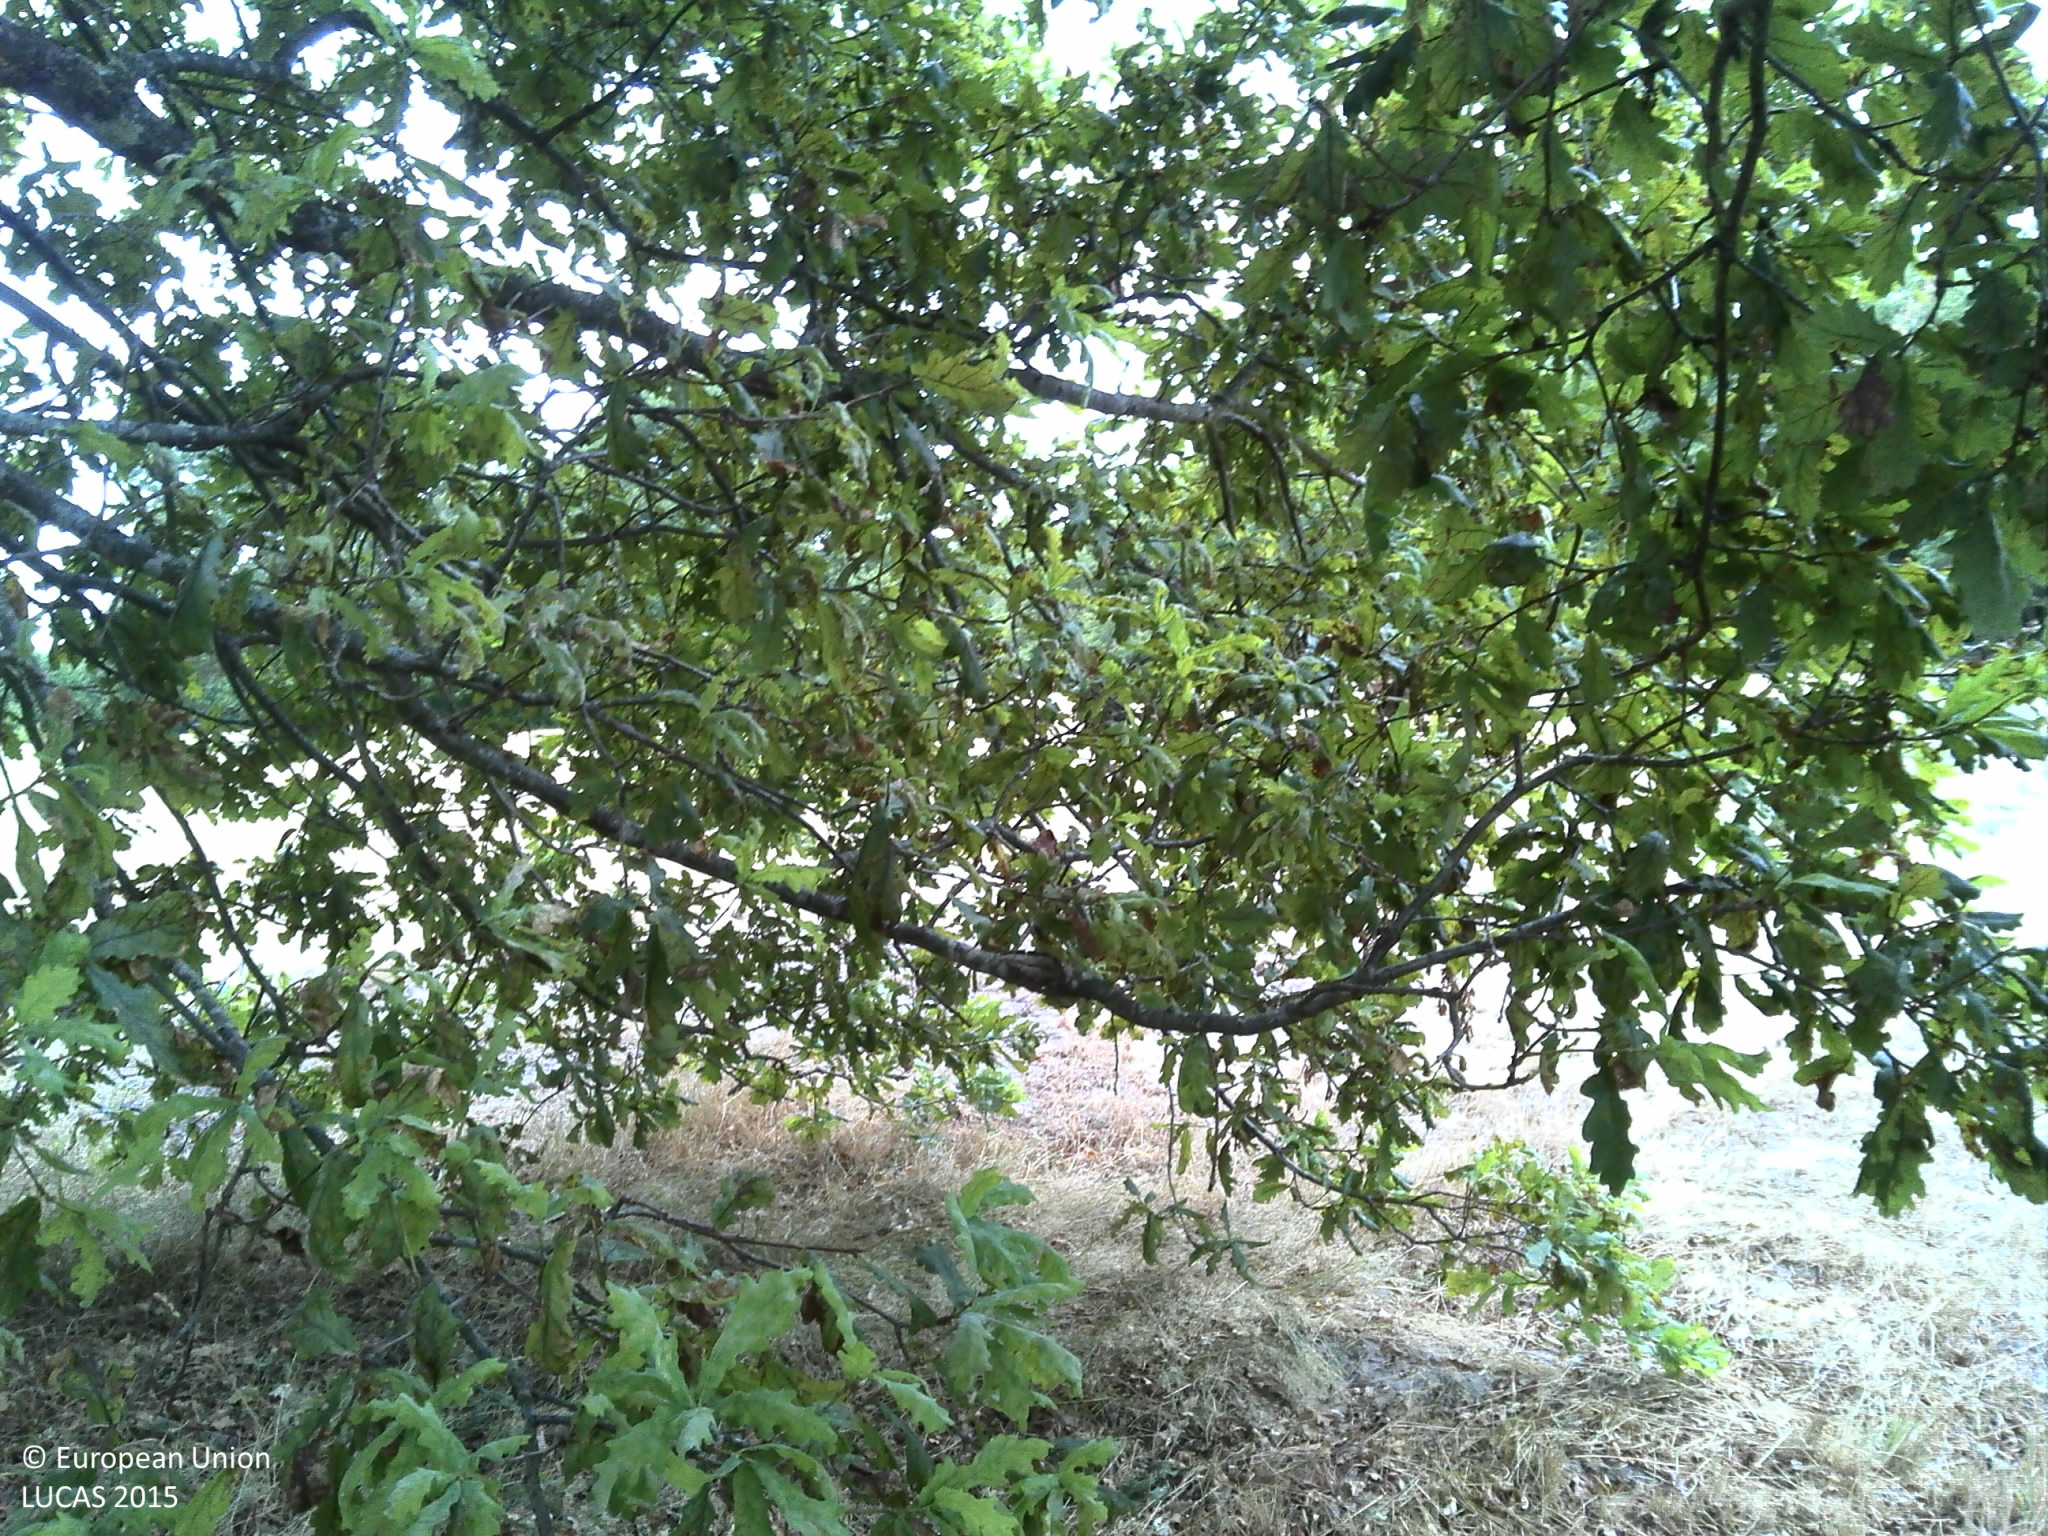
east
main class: Shrubland
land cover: Shrubland with sparse tree cover
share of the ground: > 75 %
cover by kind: herbaceous plants 50 %, shrubs 45 %, broadleaved forest trees 5 %
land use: Agriculture (excluding fallow land and kitchen gardens)
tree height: < 5 m
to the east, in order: Shrubland with sparse tree cover; Fences; Grass margins; Ditches and canals; Other bare soil; Grassland without tree/shrub cover; Fences; Grassland without tree/shrub cover; Other fresh vegetables; Fences; Grassland without tree/shrub cover; Ditches and canals; Electric lines; Grass margins; Paved roads, cycling and walking lanes; Grass margins; Ditches and canals
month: August
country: FR
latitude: 45.1748
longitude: -0.5434
